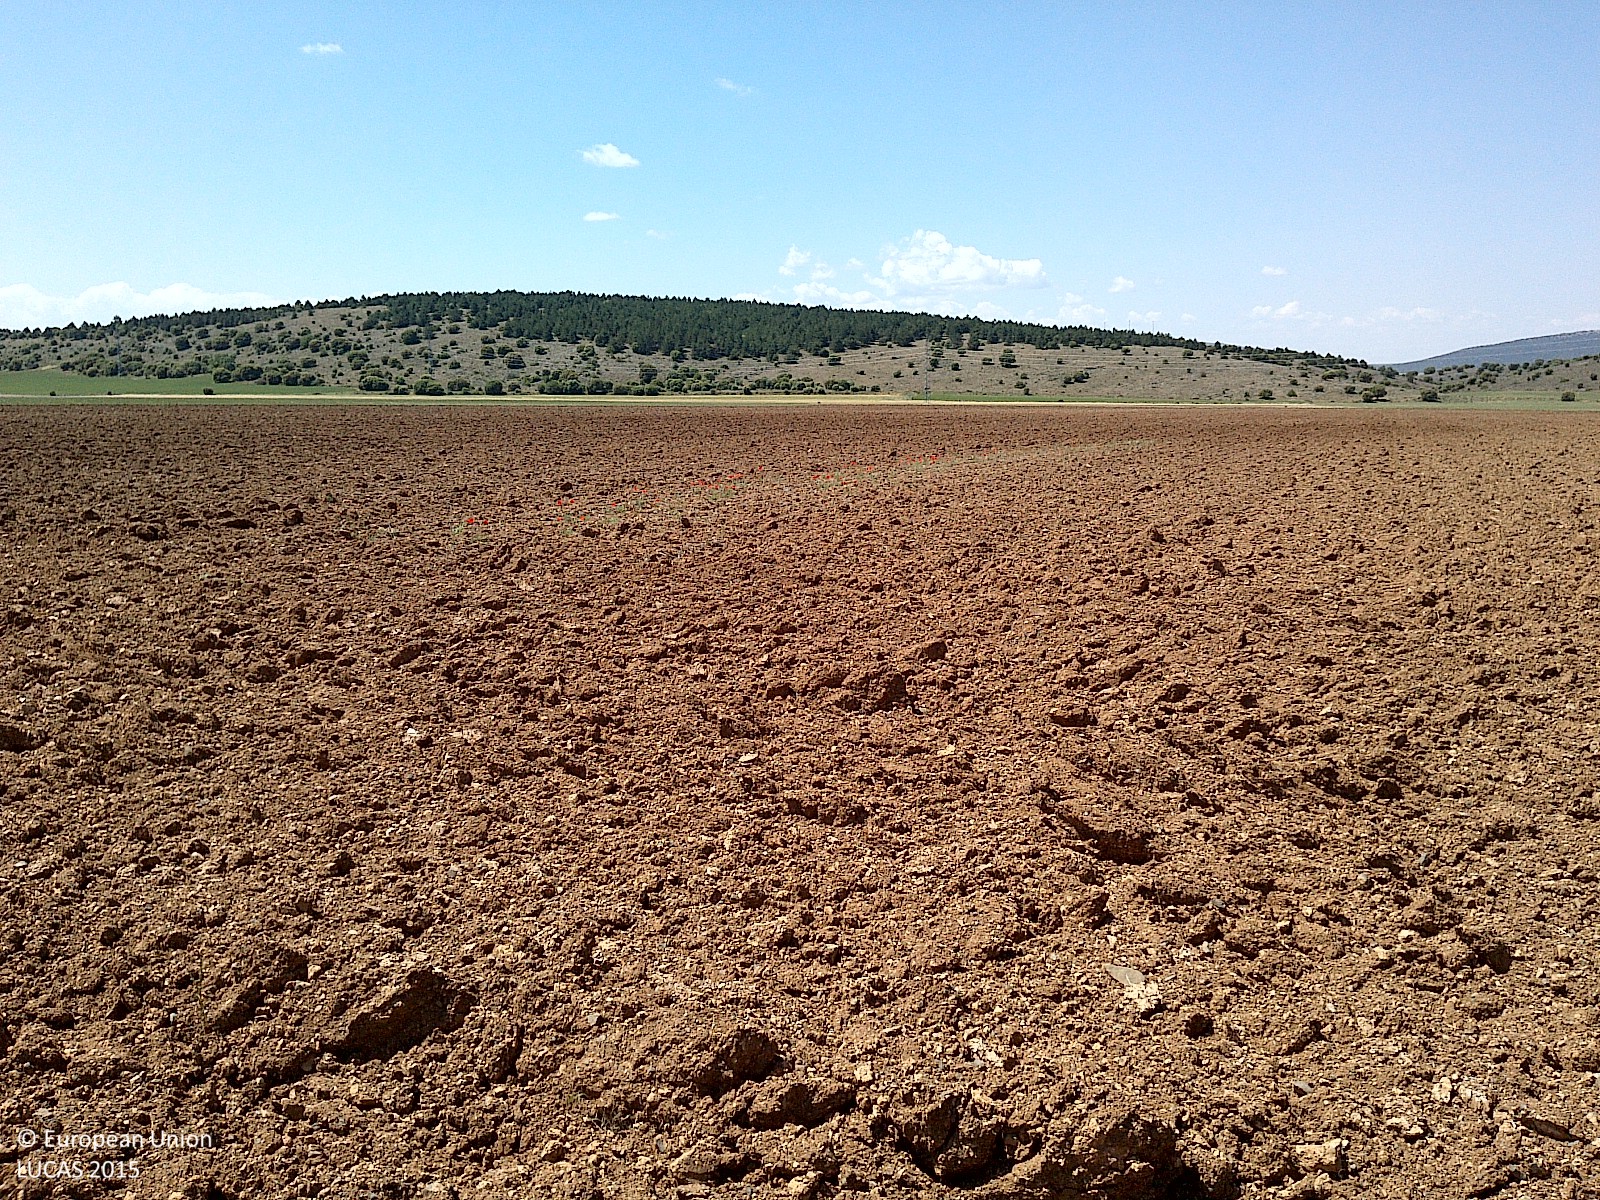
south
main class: Cropland
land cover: Barley
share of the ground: > 75 %
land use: Agriculture (excluding fallow land and kitchen gardens)
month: June
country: ES
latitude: 41.7647
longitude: -2.0743
